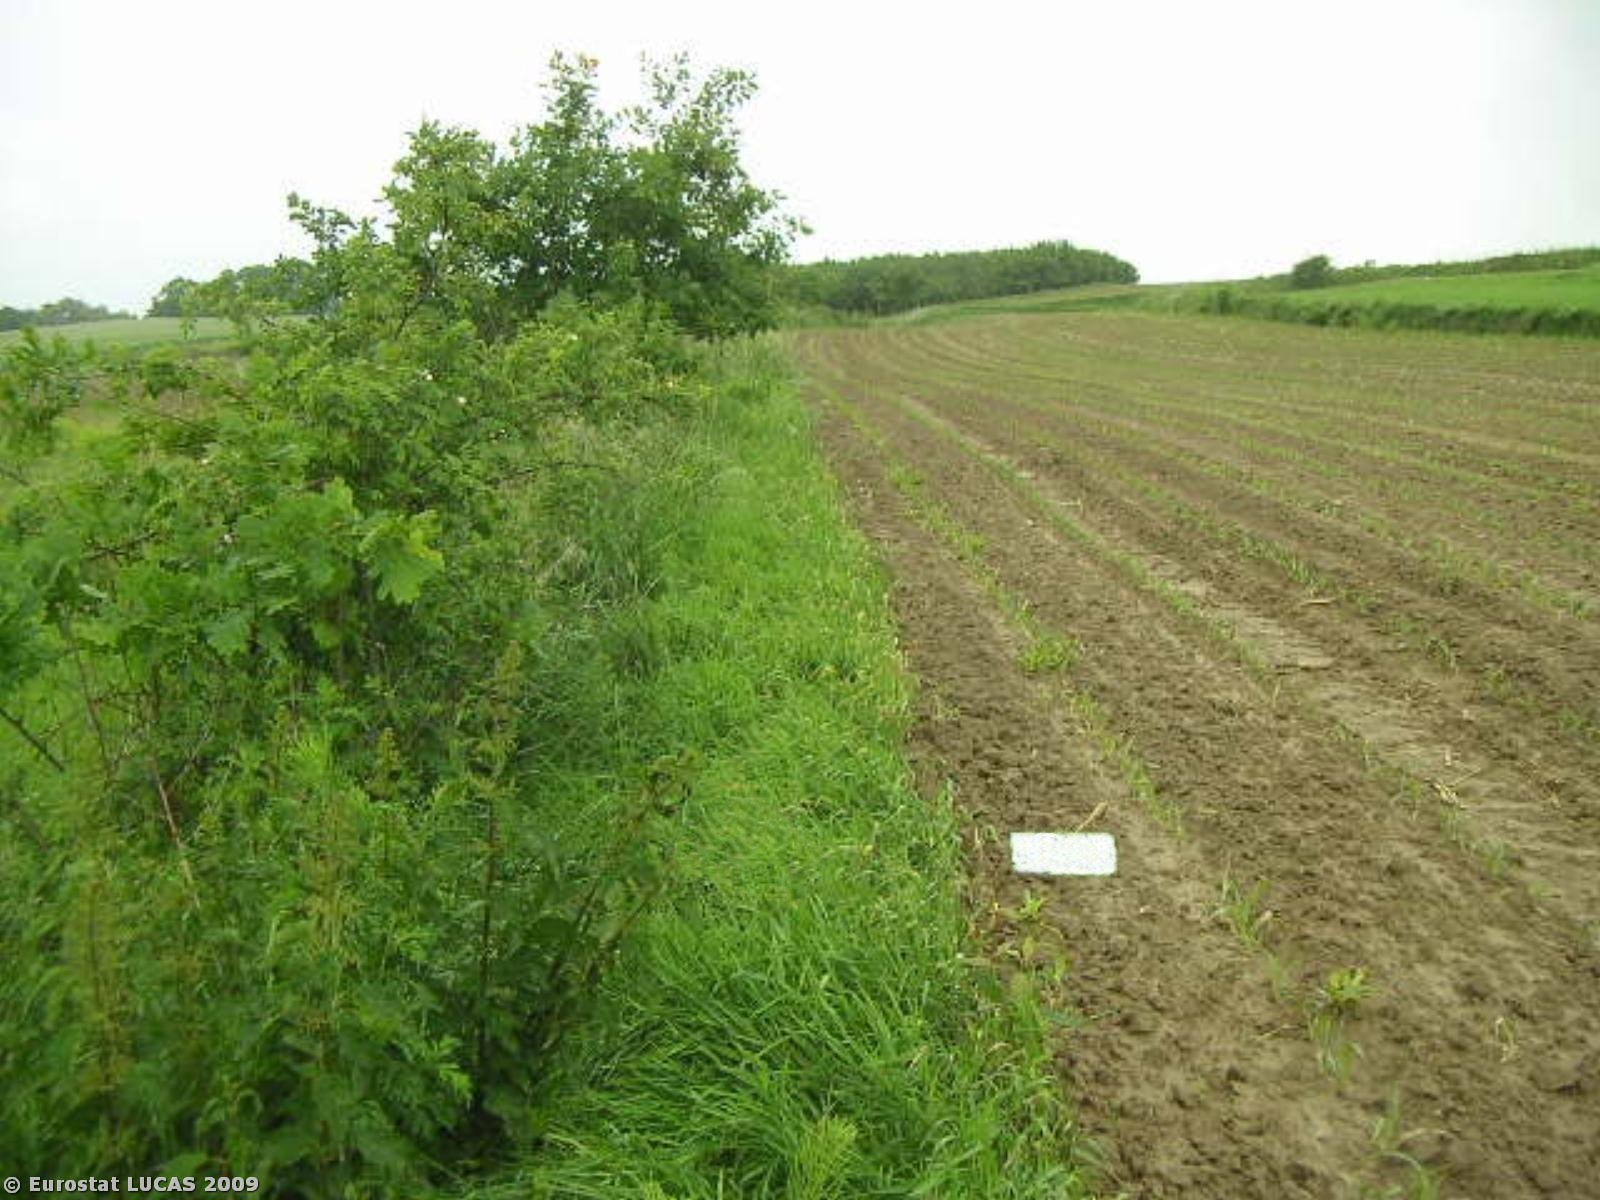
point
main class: Cropland
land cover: Maize
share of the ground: 50 - 75 %
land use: Agriculture (excluding fallow land and kitchen gardens)
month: May
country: PL
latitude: 50.0635
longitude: 19.6538
